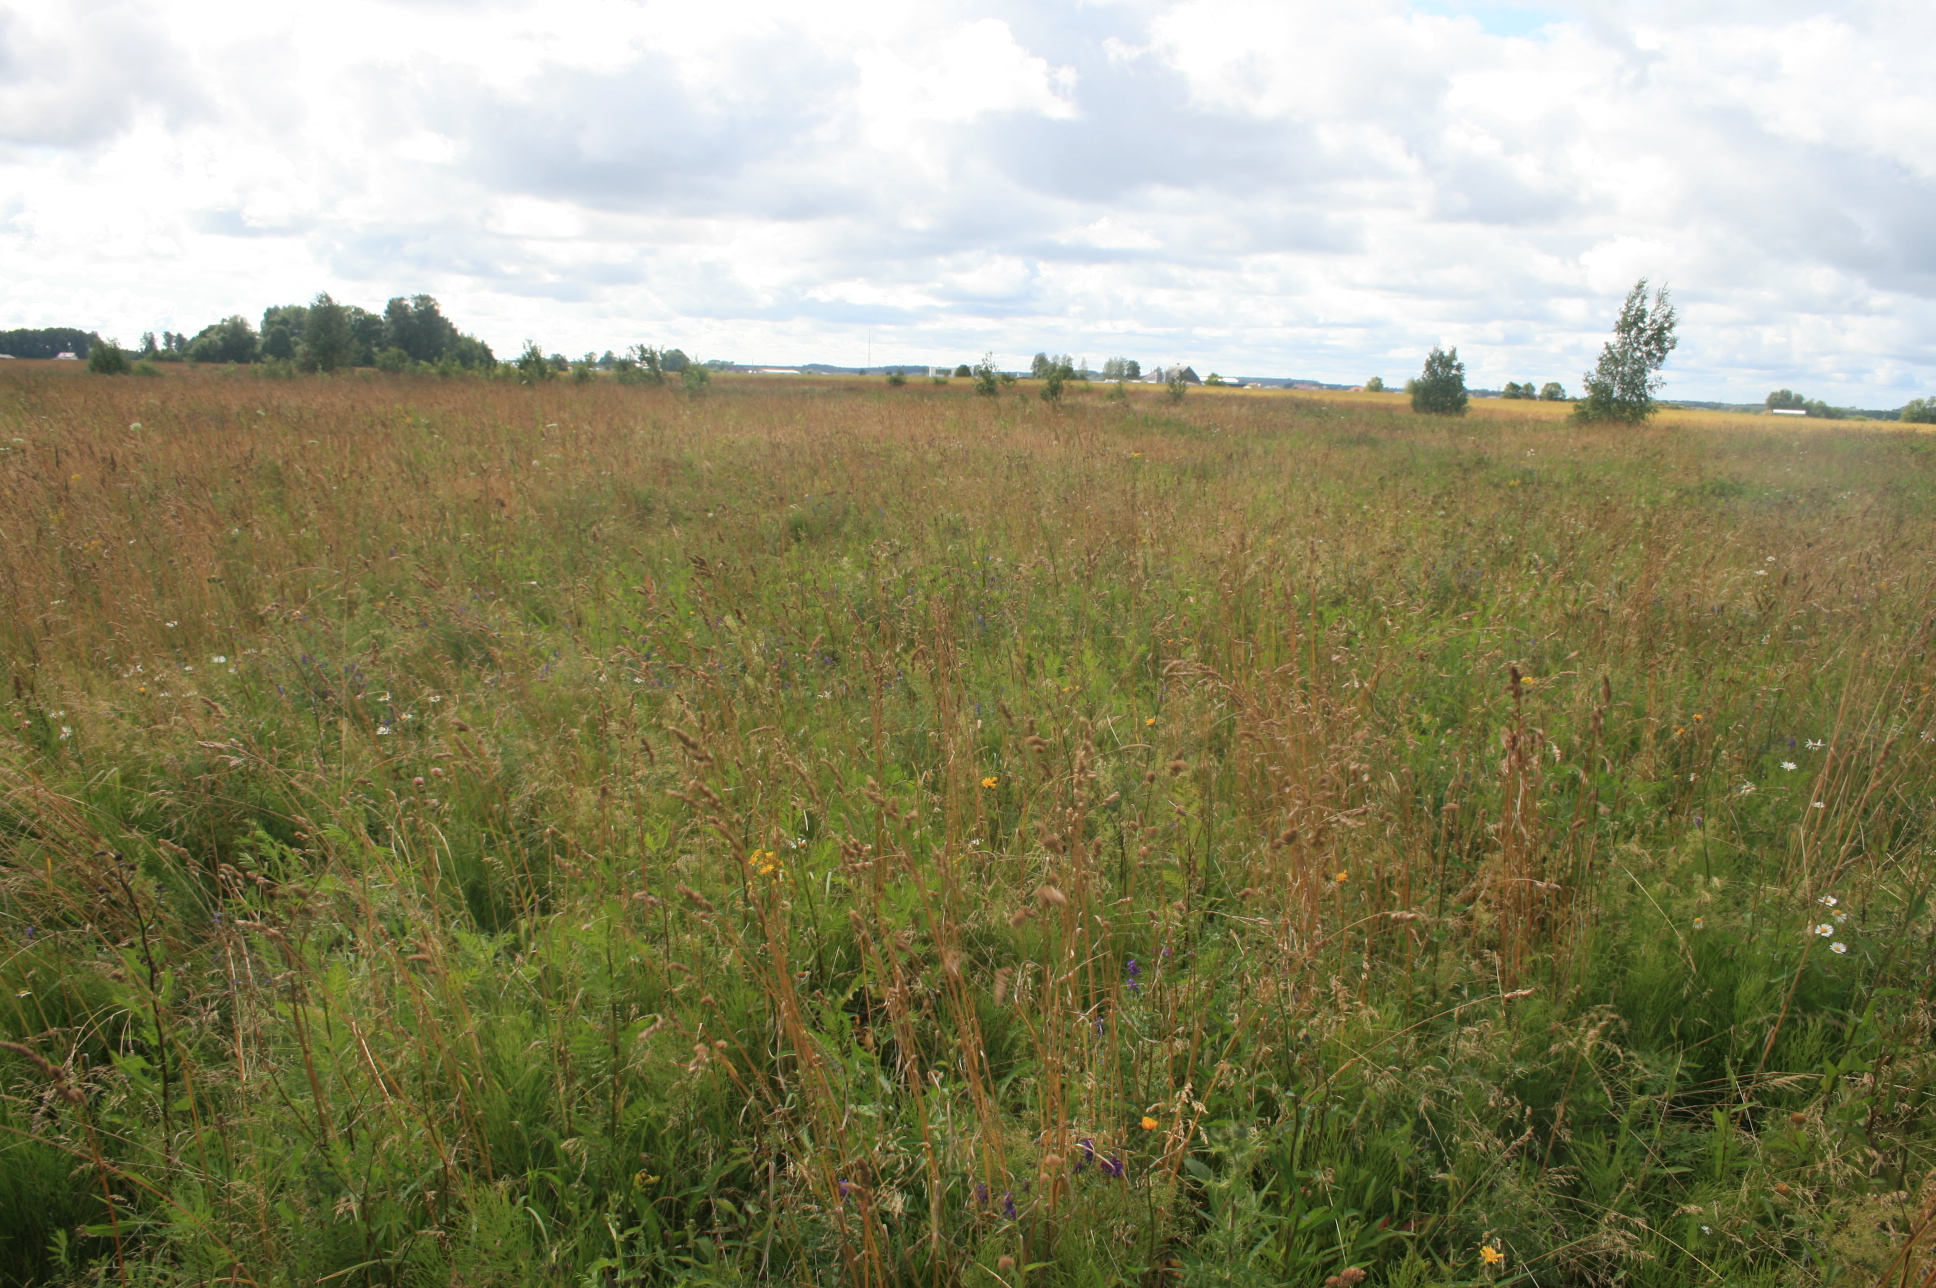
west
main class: Grassland
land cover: Grassland without tree/shrub cover
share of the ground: > 75 %
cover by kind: herbaceous plants 100 %
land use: Agriculture (excluding fallow land and kitchen gardens)
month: July
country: LT
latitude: 55.7672
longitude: 21.2143
